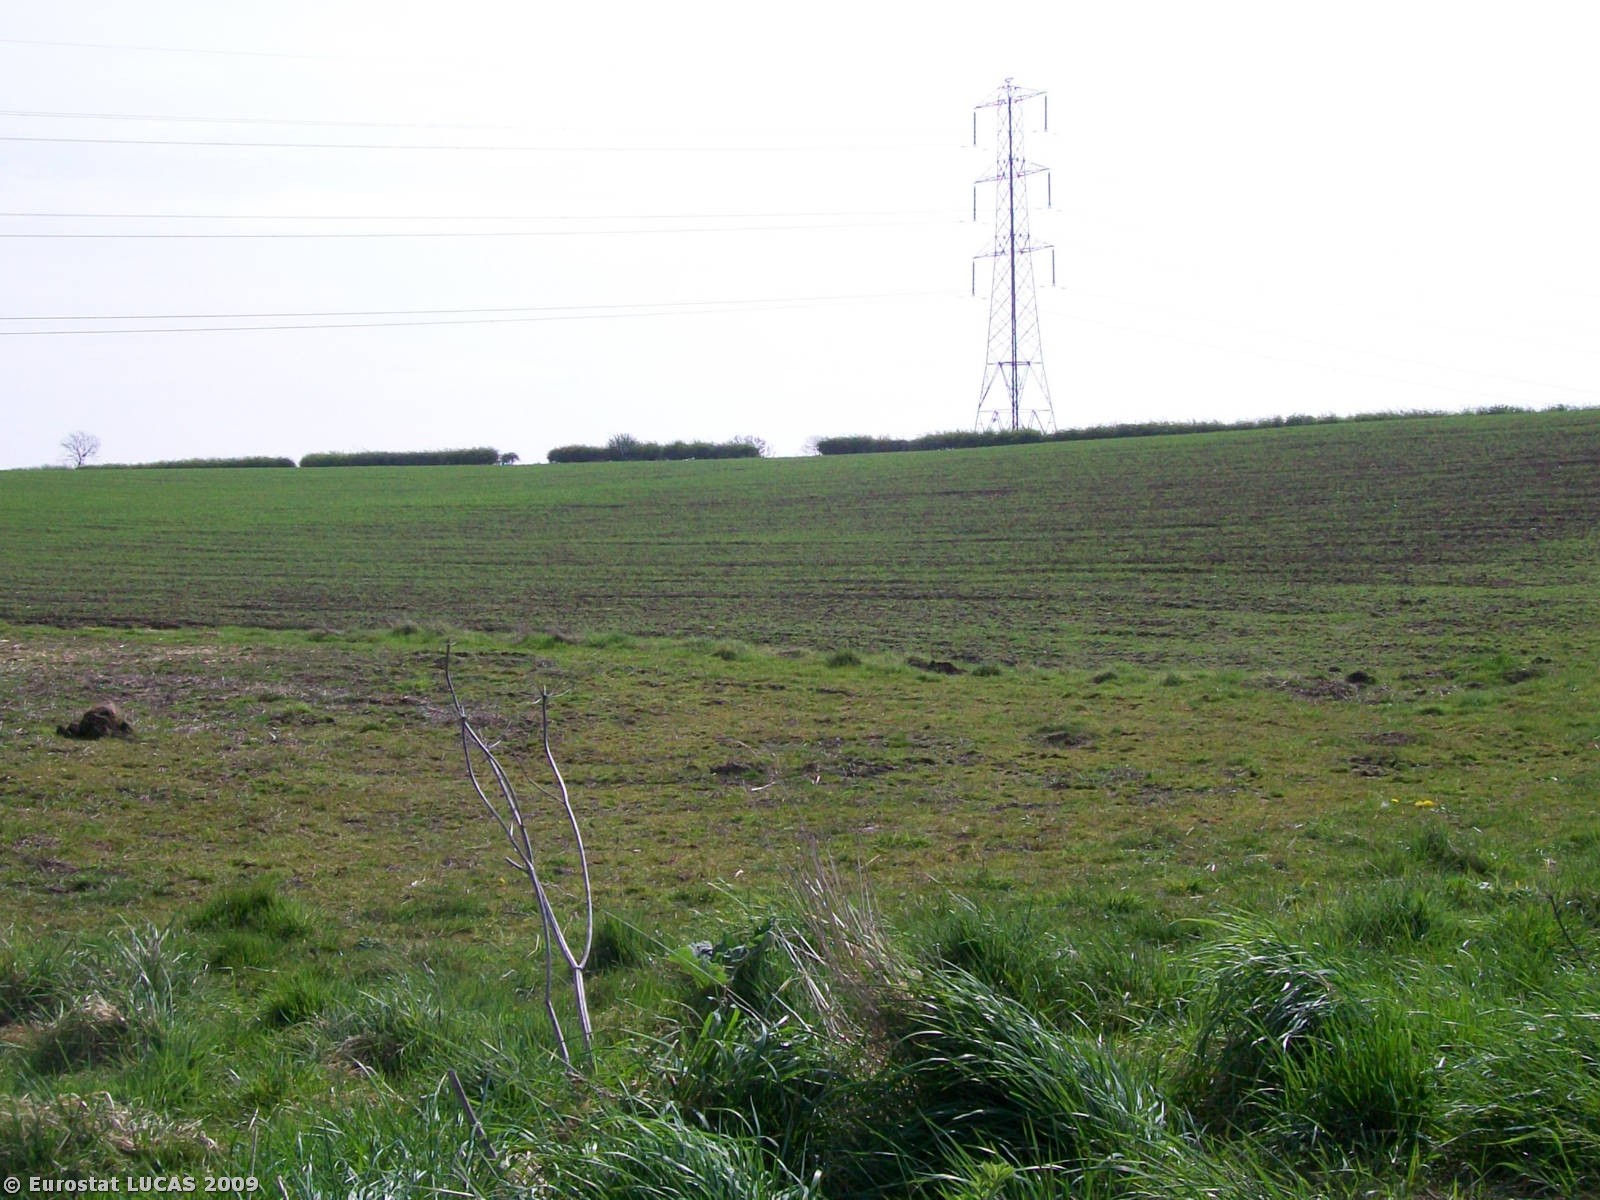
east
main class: Grassland
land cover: Grassland without tree/shrub cover
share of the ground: > 75 %
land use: Agriculture (excluding fallow land and kitchen gardens)
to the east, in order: Grassland without tree/shrub cover; Managed hedges; Fences; Oats
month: April
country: GB
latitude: 54.6528
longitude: -1.2821
